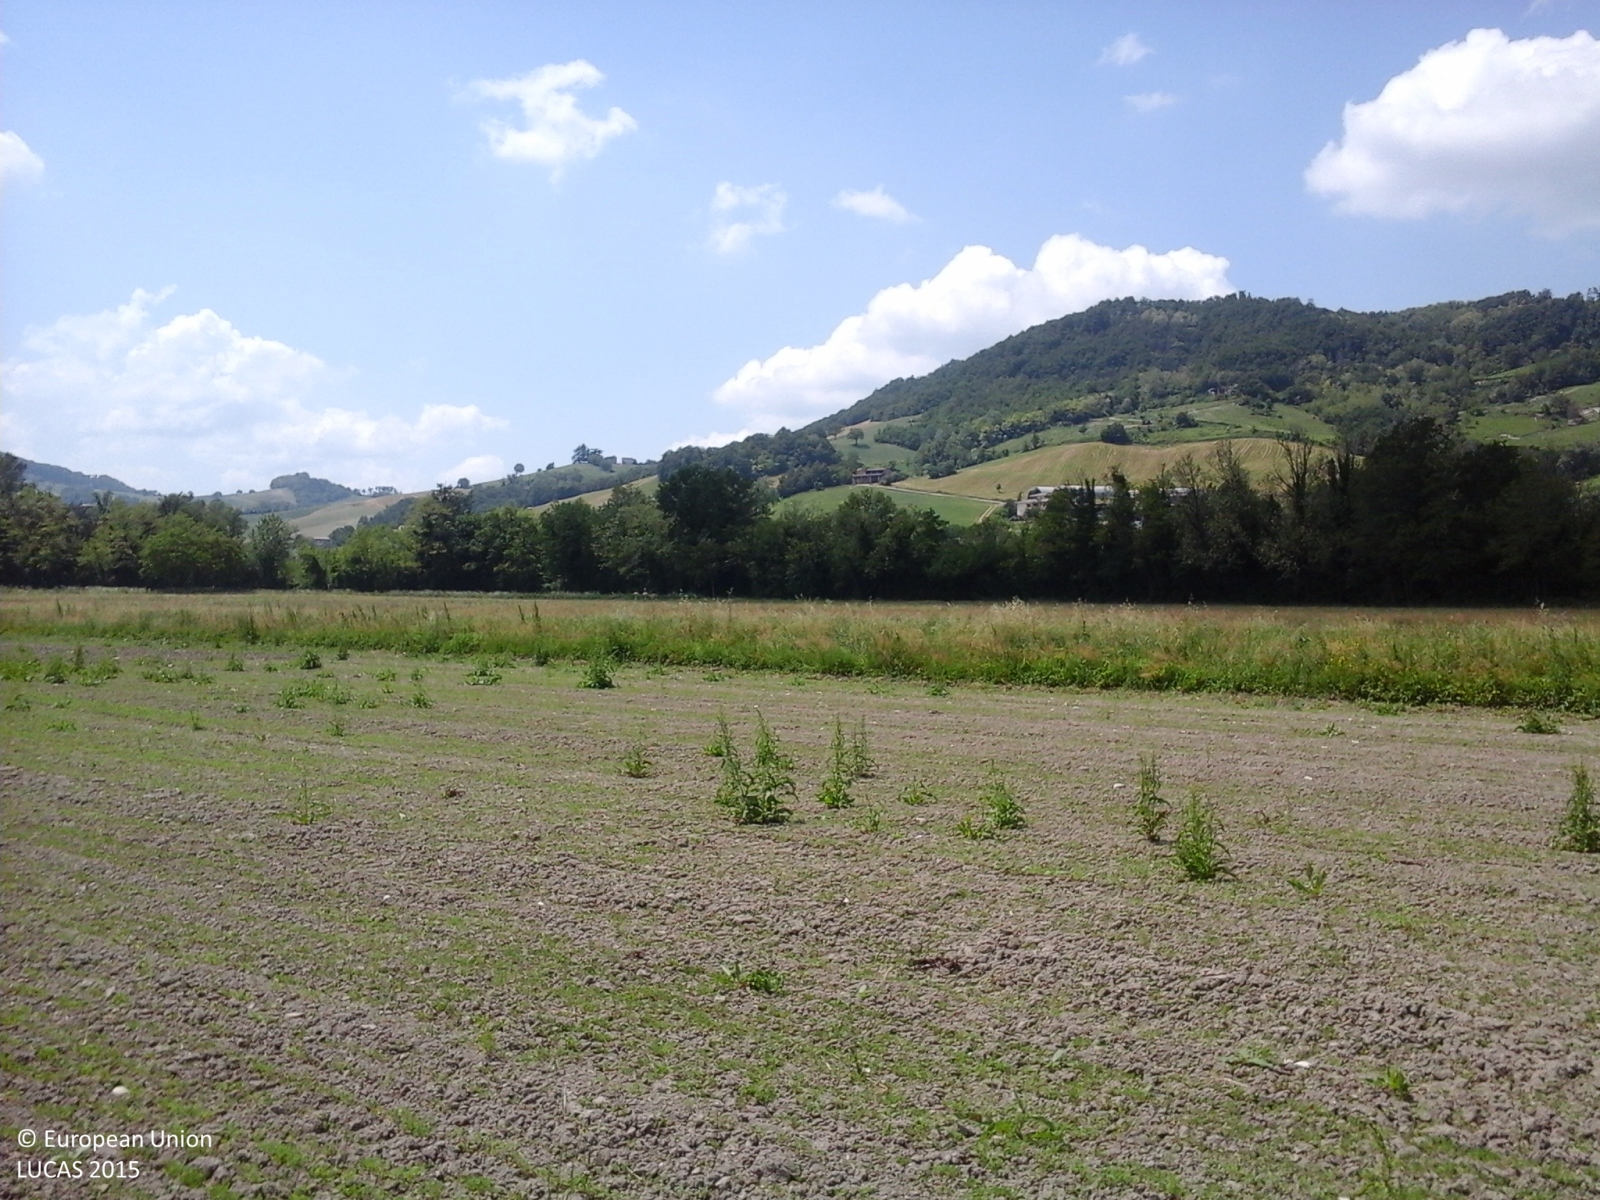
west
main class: Cropland
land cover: Lucerne
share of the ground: < 10 %
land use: Agriculture (excluding fallow land and kitchen gardens)
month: May
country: IT
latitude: 44.6570
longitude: 10.1888
